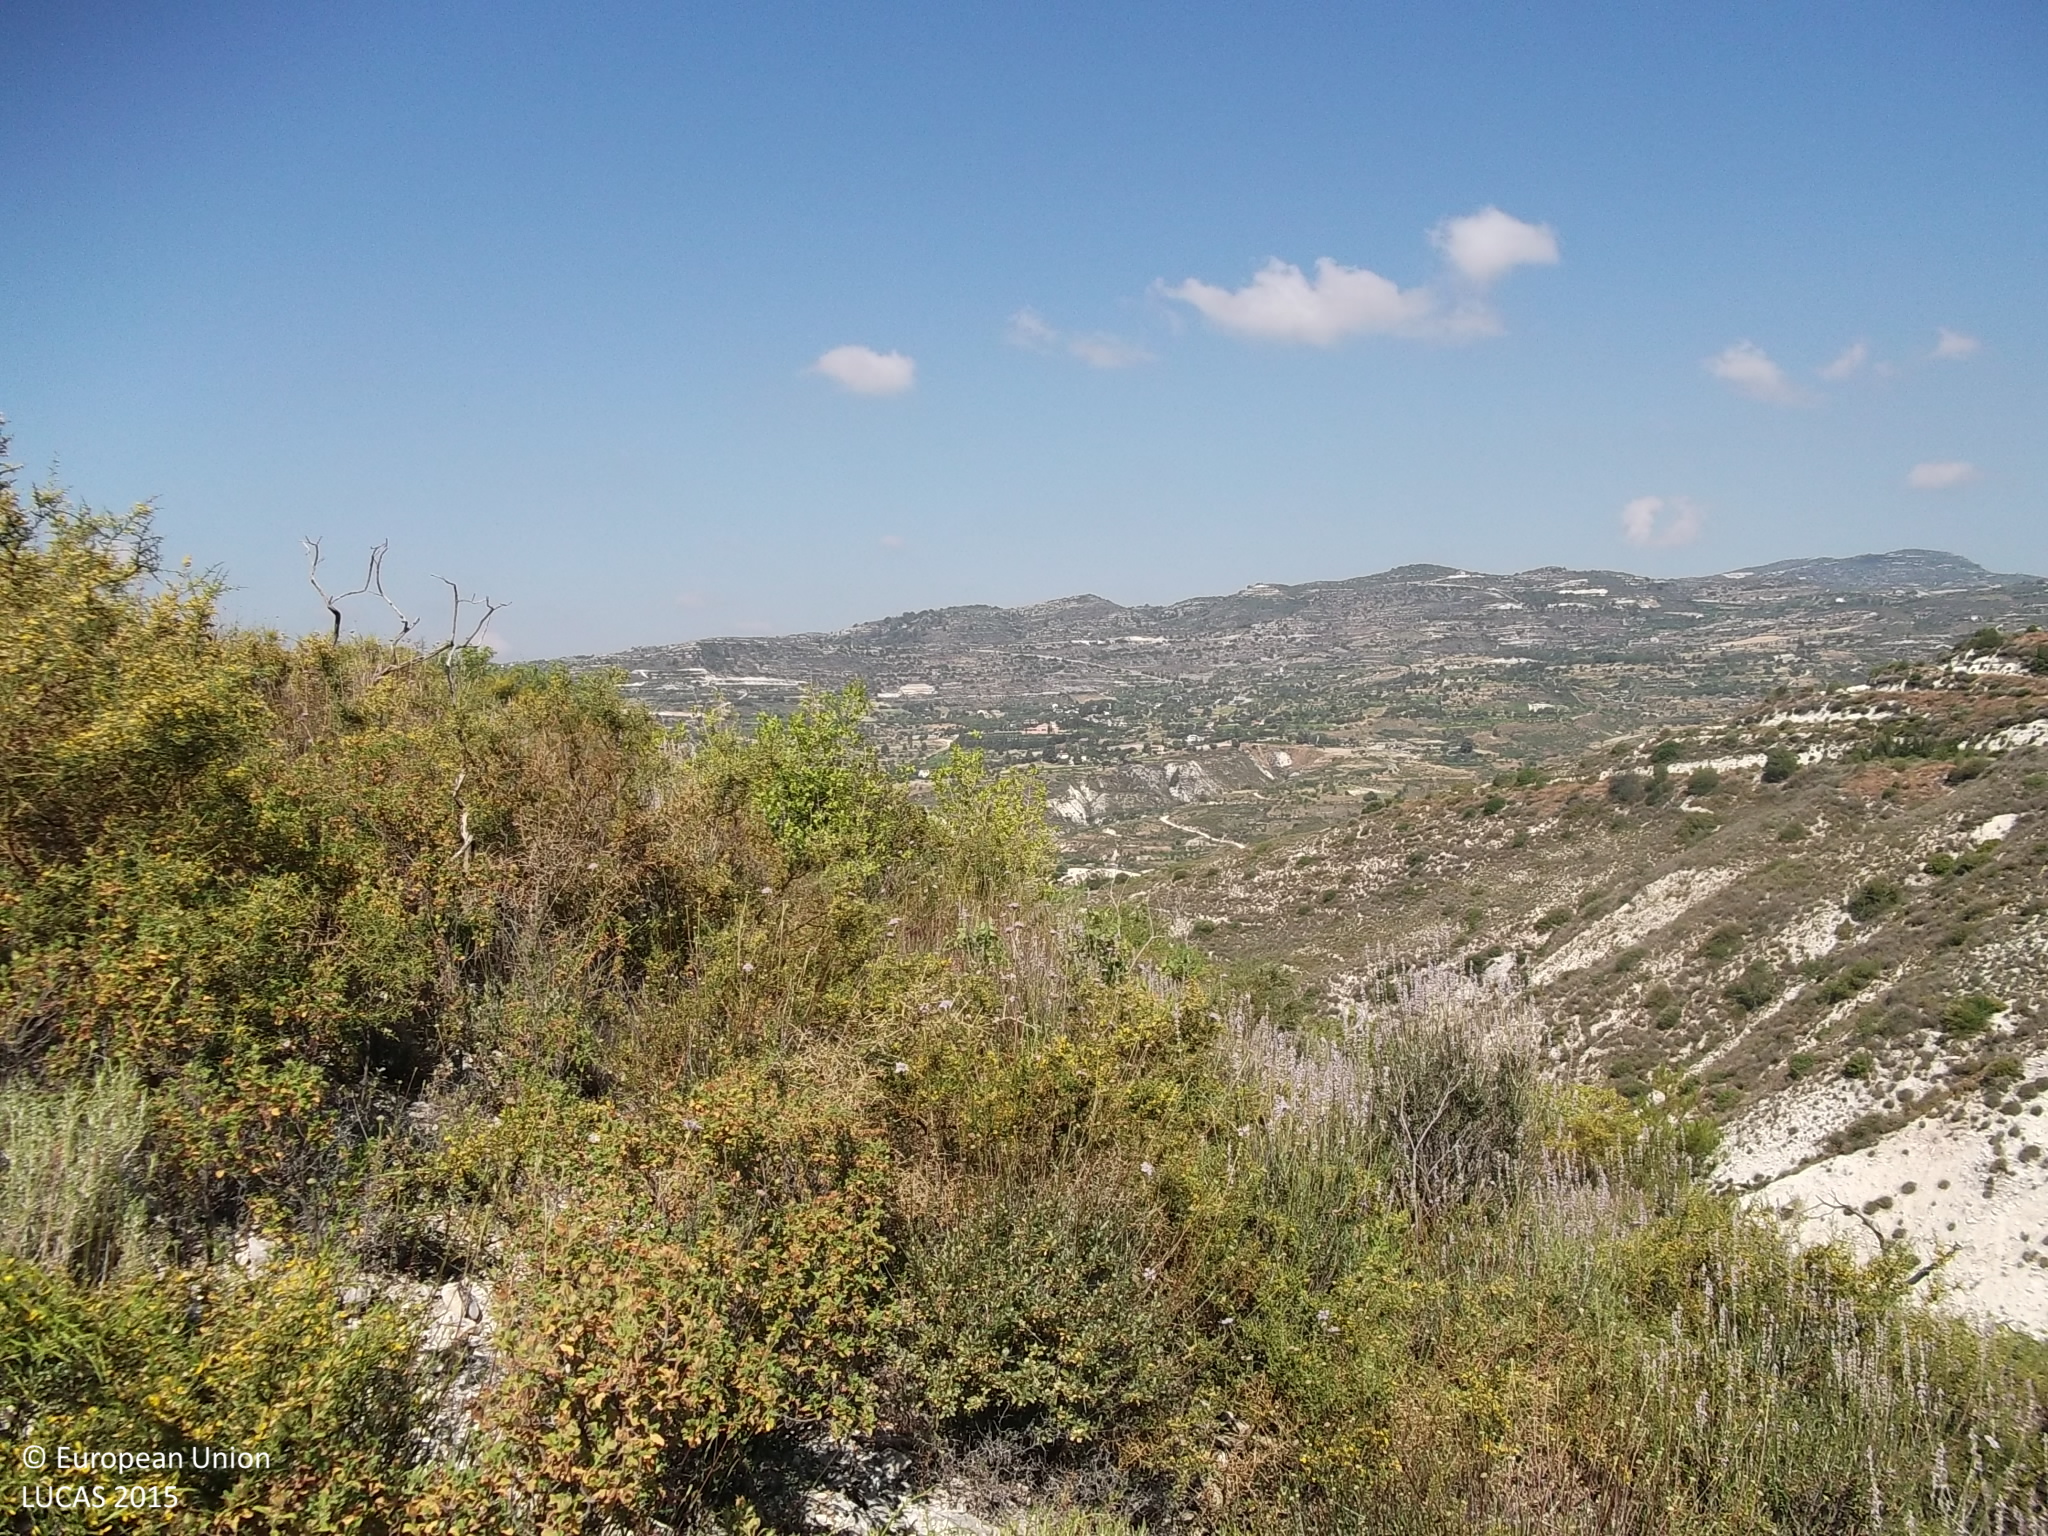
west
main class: Shrubland
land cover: Shrubland without tree cover
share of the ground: 25 - 50 %
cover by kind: shrubs 50 %, unconsolidated bare surface 40 %, consolidated bare surface 10 %
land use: Semi-natural and natural areas not in use
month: June
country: CY
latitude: 34.8331
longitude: 32.9201
